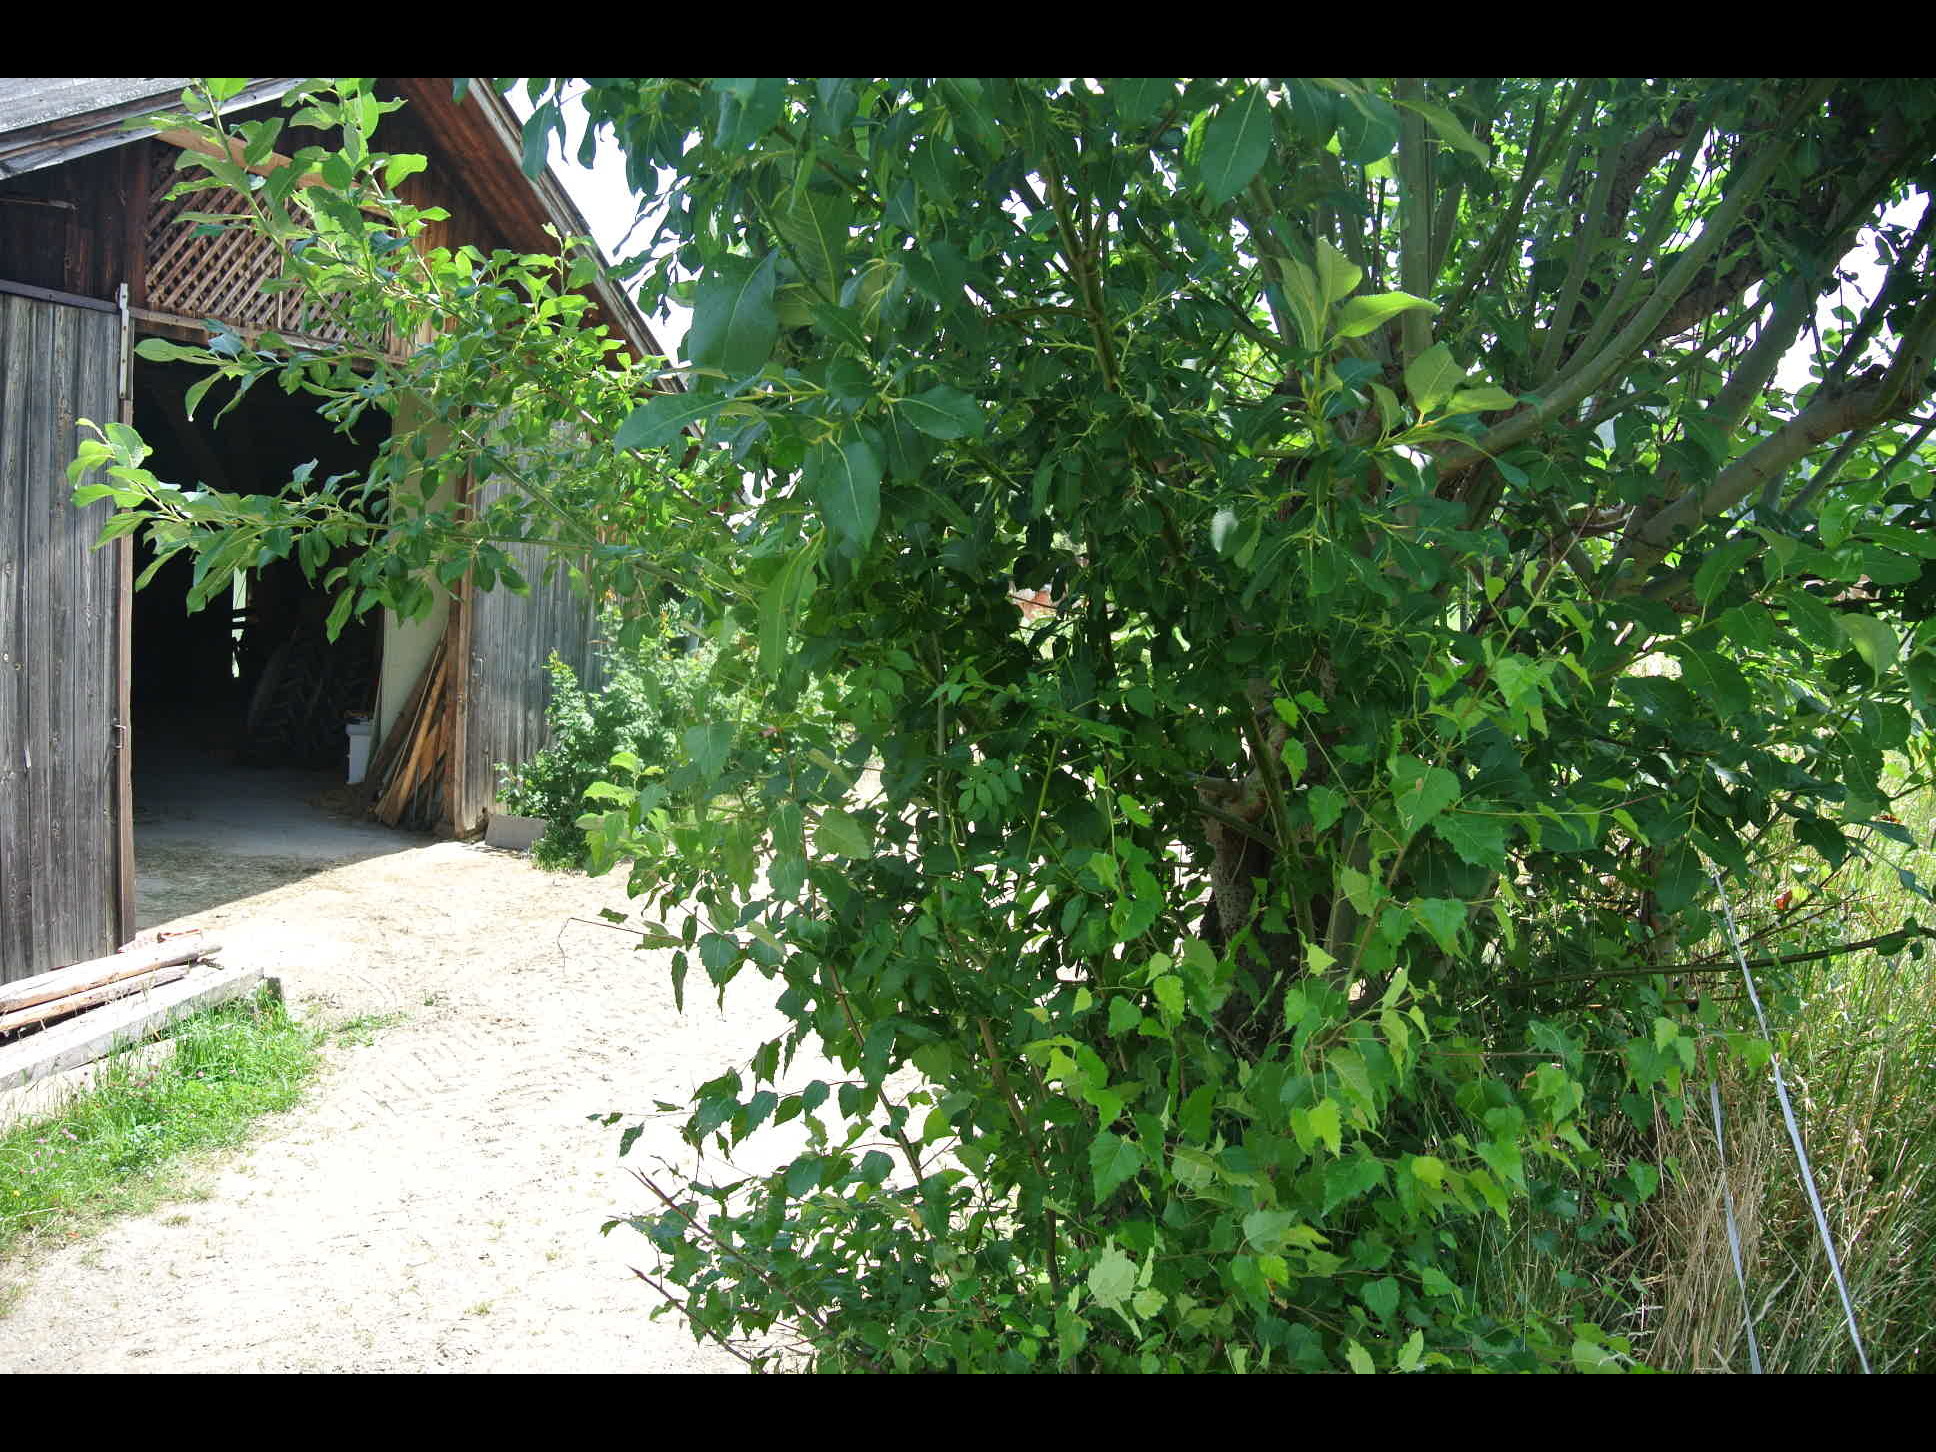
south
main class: Cropland
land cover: Temporary grasslands
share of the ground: > 75 %
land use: Agriculture (excluding fallow land and kitchen gardens)
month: July
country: AT
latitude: 47.6447
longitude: 16.0062
